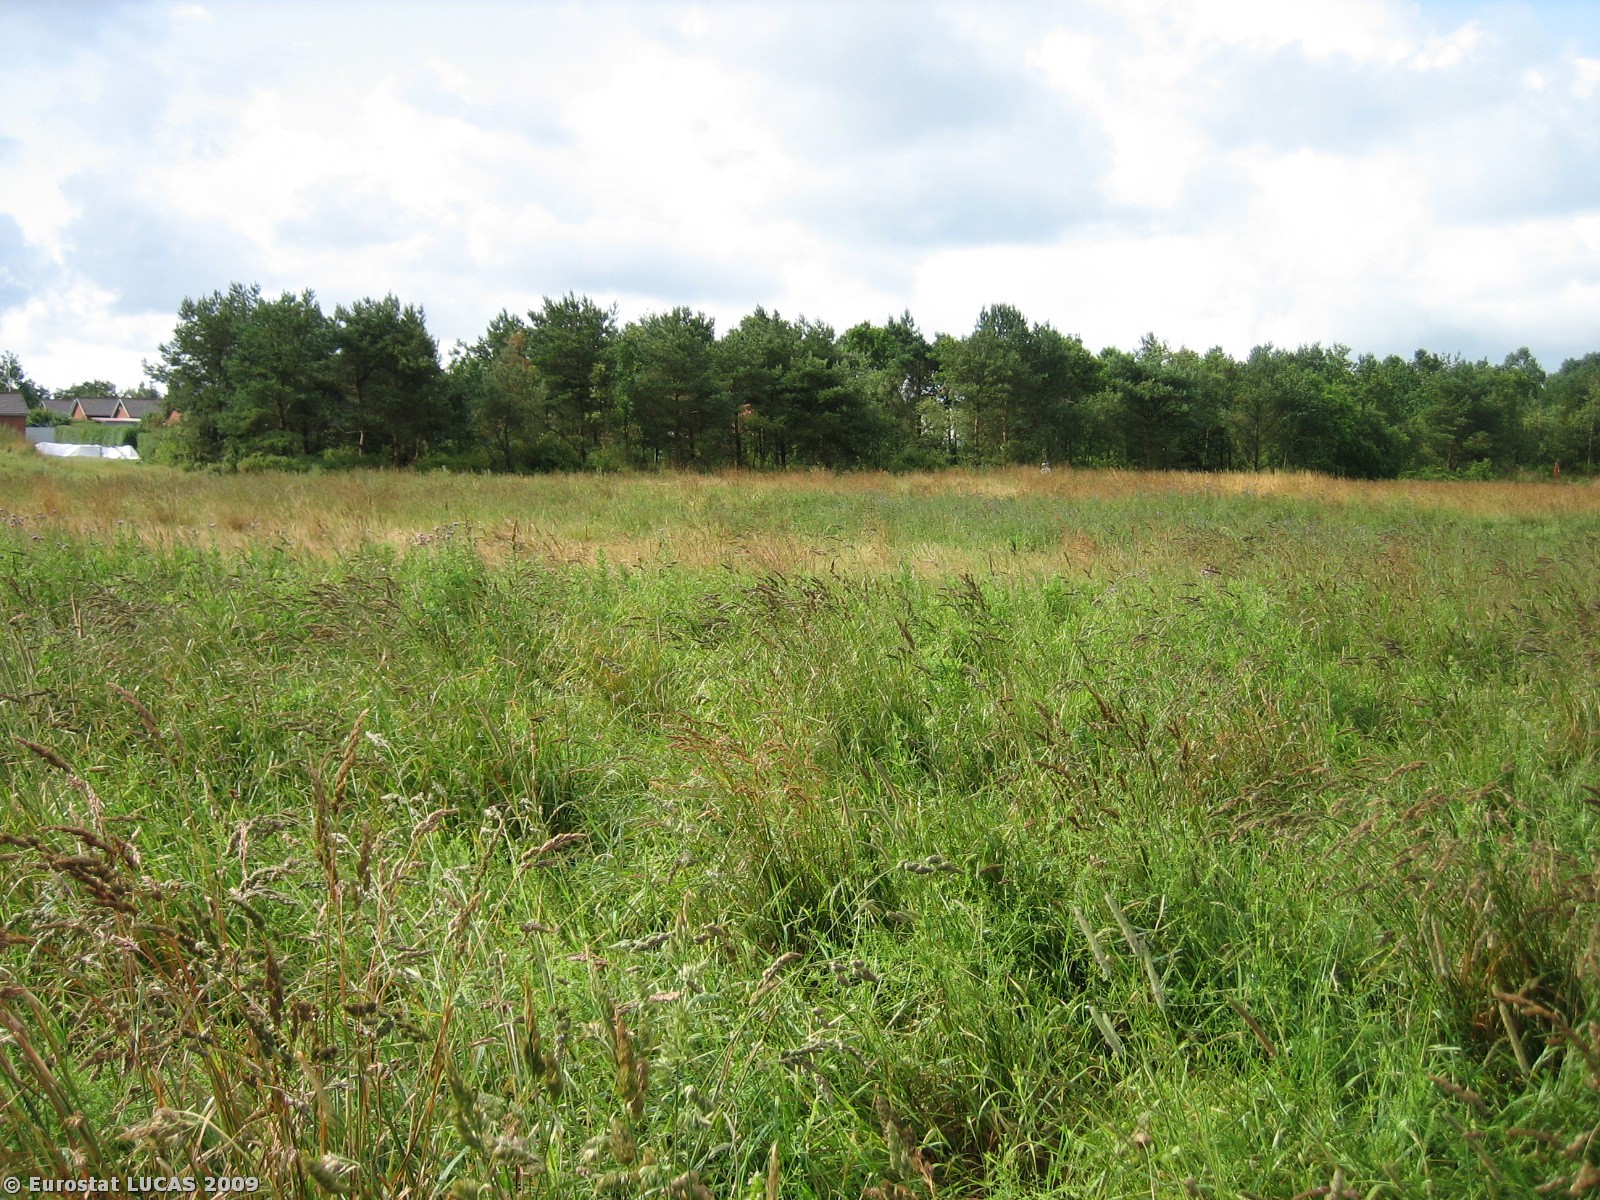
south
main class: Grassland
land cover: Grassland without tree/shrub cover
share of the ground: > 75 %
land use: Amenities, museums, leisure
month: July
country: DK
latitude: 55.5130
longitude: 8.4336
